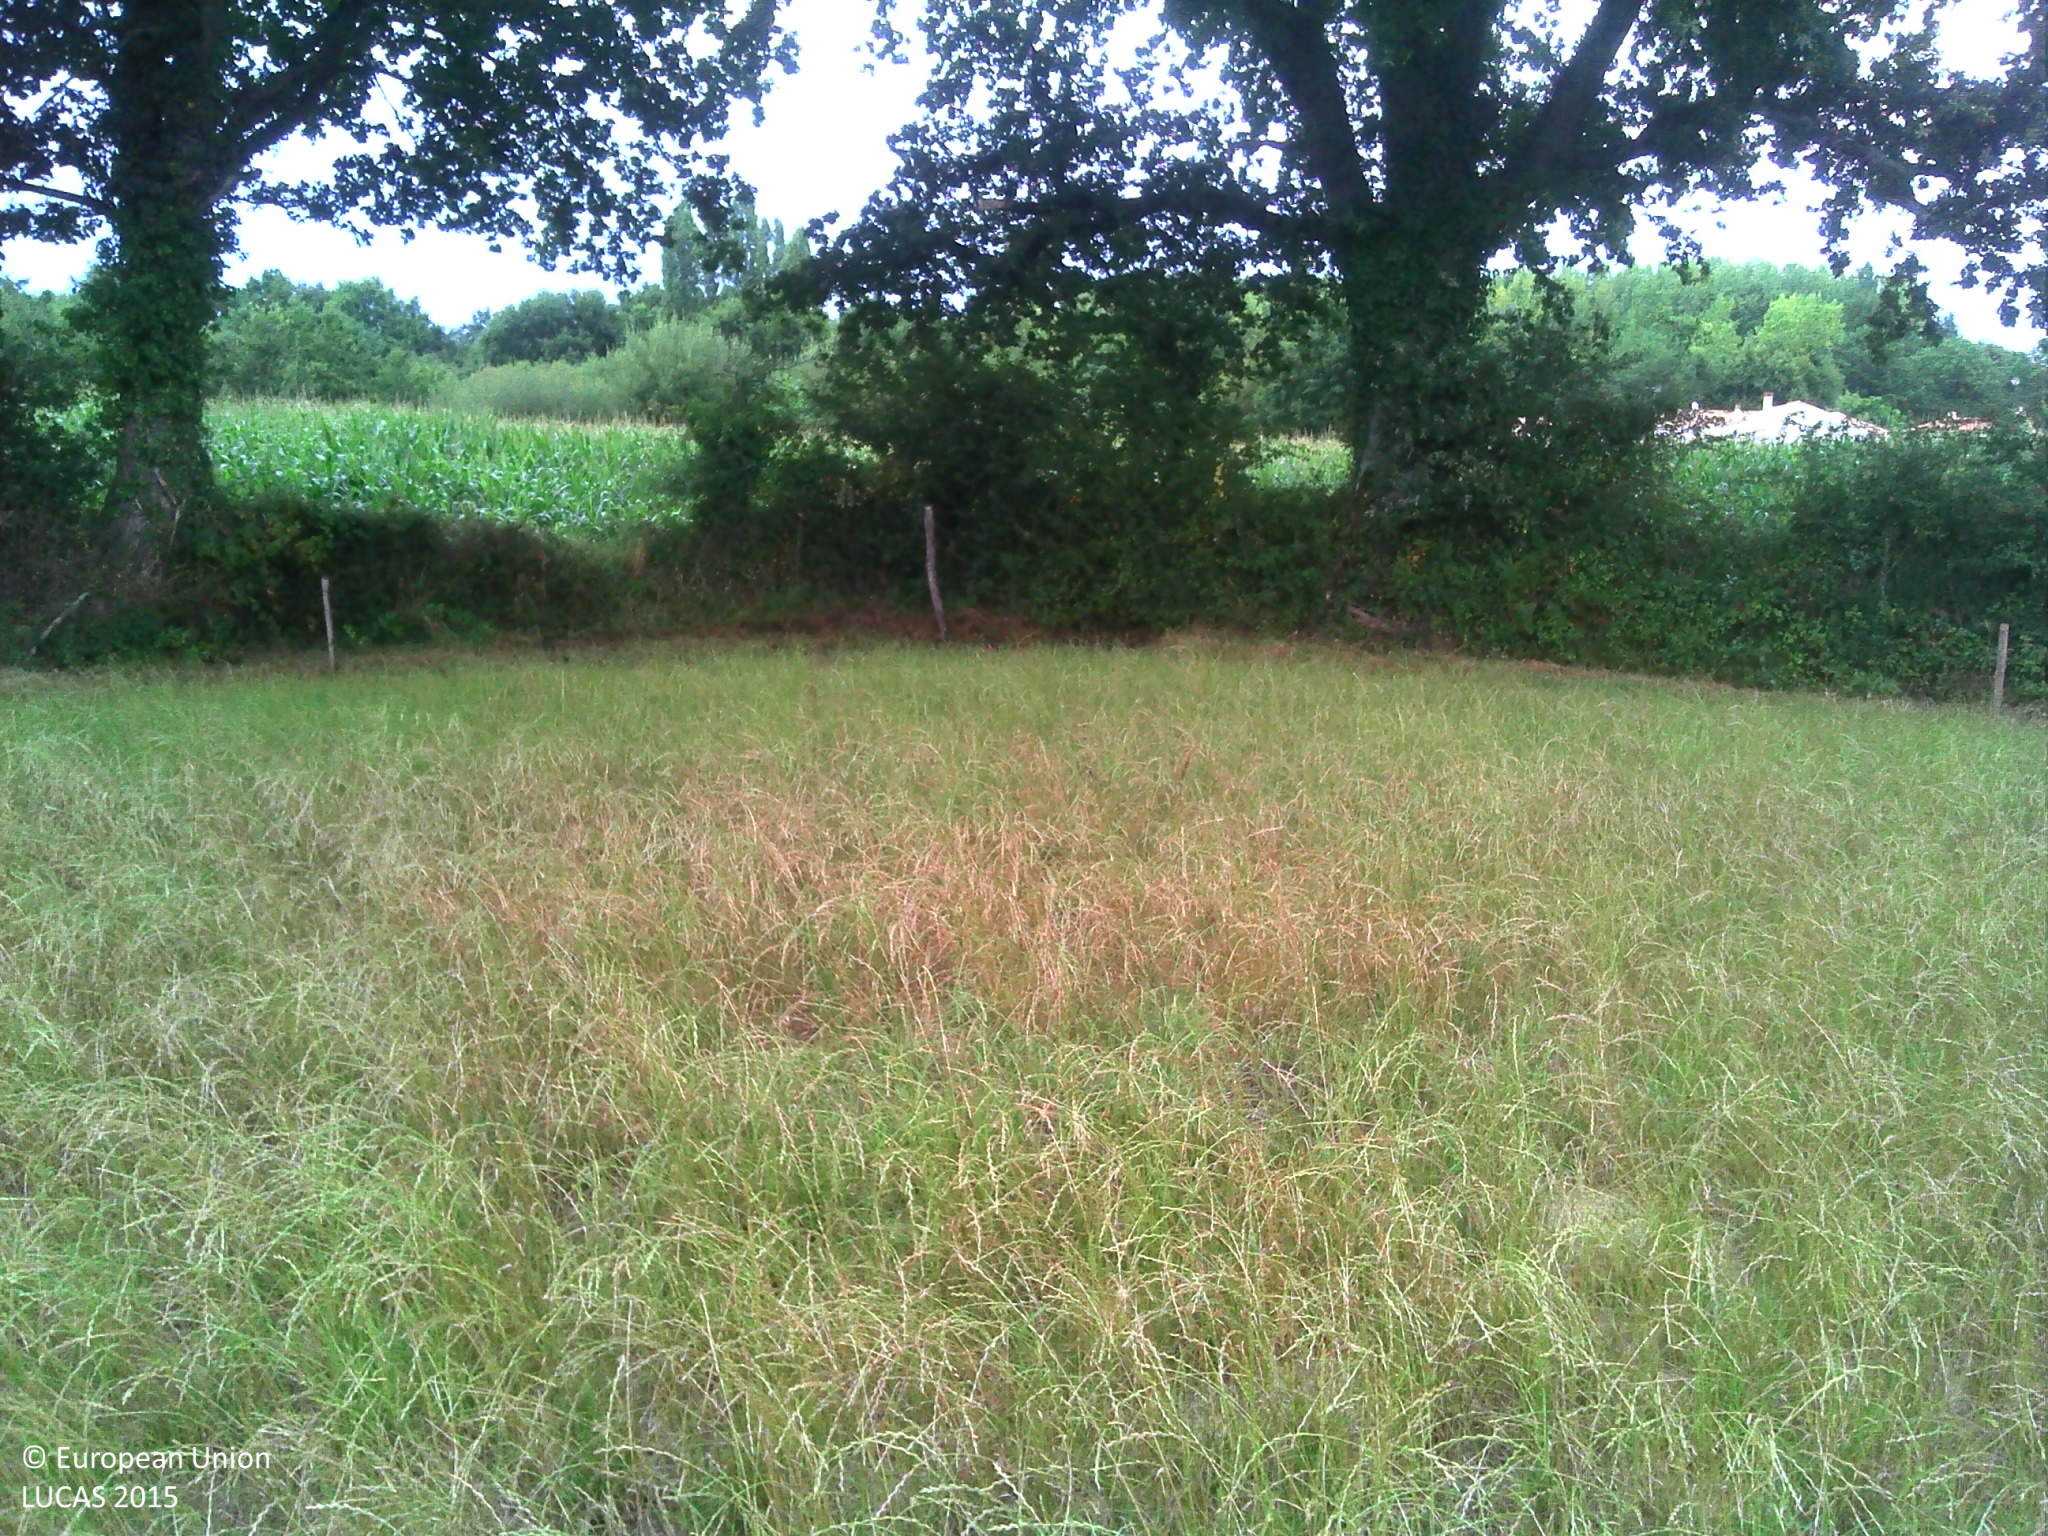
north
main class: Grassland
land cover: Grassland without tree/shrub cover
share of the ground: > 75 %
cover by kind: herbaceous plants 100 %
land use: Agriculture (excluding fallow land and kitchen gardens)
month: August
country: FR
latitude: 46.6422
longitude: -1.6282
